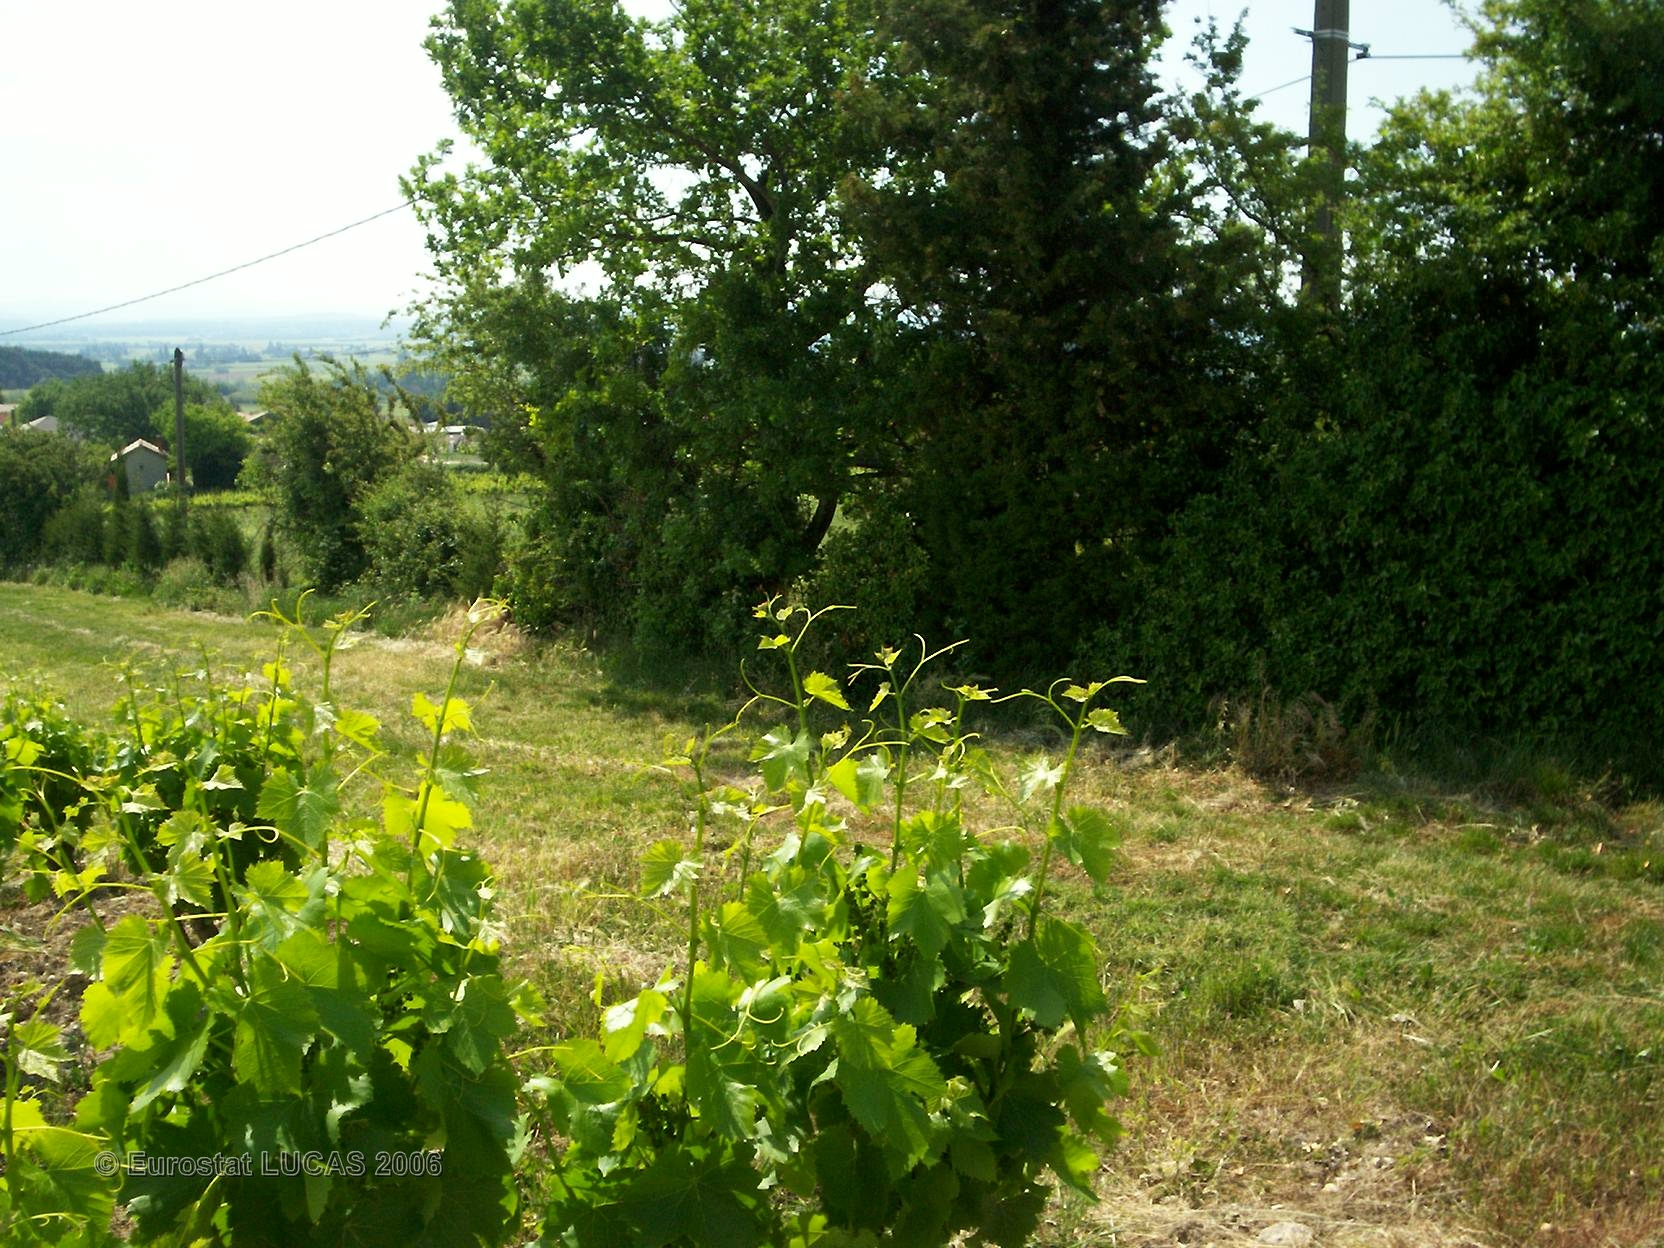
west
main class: Cropland
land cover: Vineyards
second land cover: Grassland with sparse tree/shrub cover
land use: Agriculture (excluding fallow land and kitchen gardens)
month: May
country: FR
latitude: 44.3182
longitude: 4.9546
